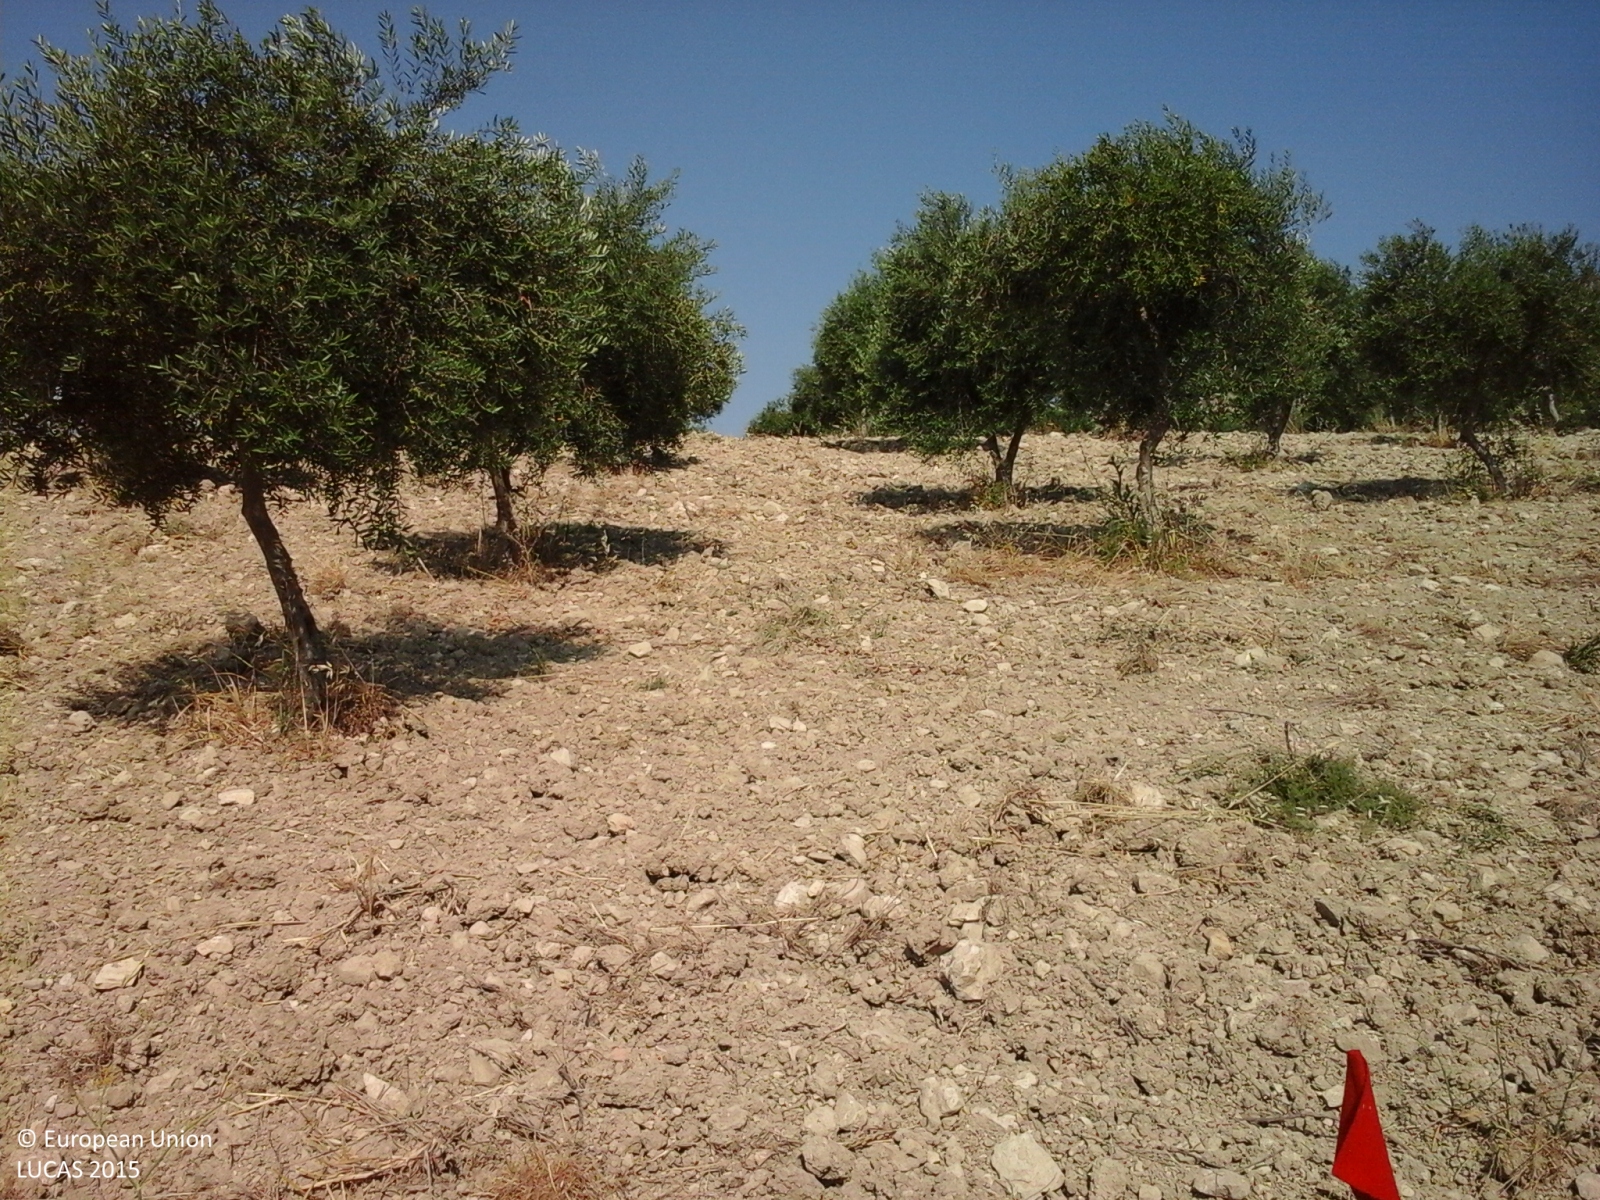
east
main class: Cropland
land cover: Olive groves
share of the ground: 25 - 50 %
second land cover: Other bare soil
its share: > 75 %
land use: Agriculture (excluding fallow land and kitchen gardens)
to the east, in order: Olive groves; Other bare soil; Grass margins; Olive groves; Vineyards; Olive groves; Artificial constructions in urban areas
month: July
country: IT
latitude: 37.5854
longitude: 13.1807
